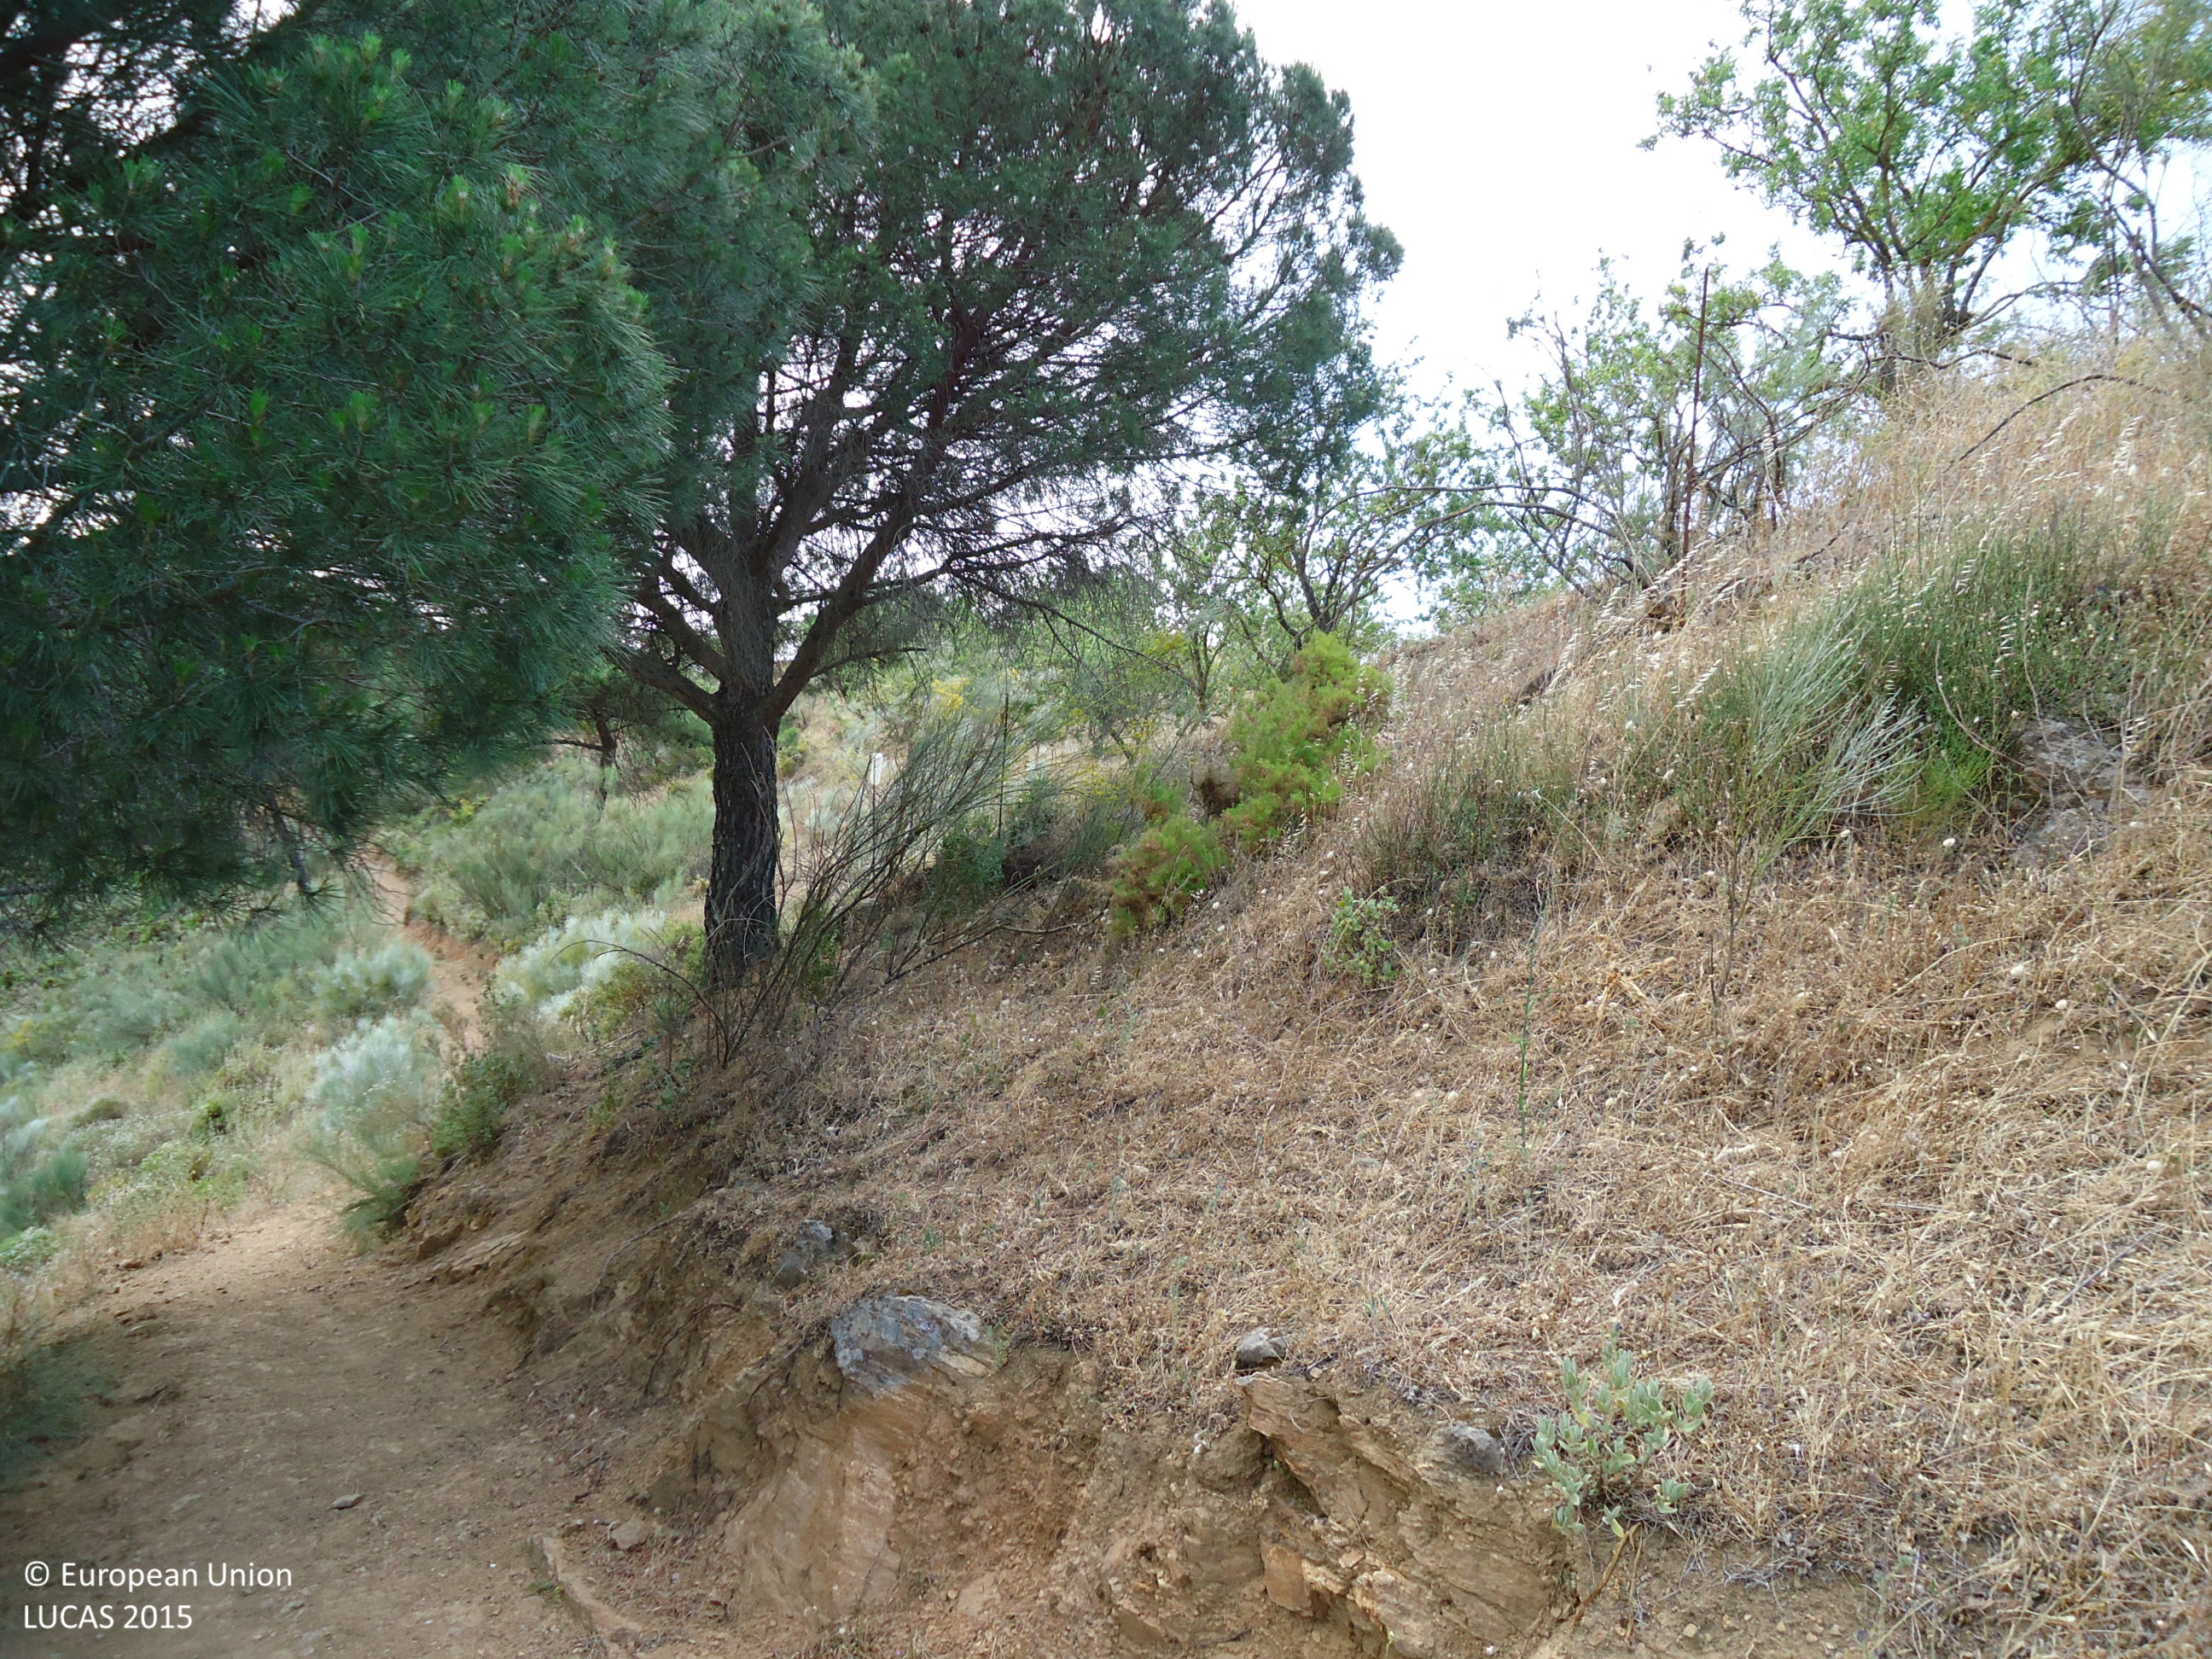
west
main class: Woodland
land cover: Pine dominated coniferous woodland
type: coniferous forest of the mediterranean region
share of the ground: 25 - 50 %
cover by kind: shrubs 75 %, coniferous forest trees 25 %
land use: Forestry
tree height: > 5 m
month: June
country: ES
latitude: 36.8600
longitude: -4.7912
